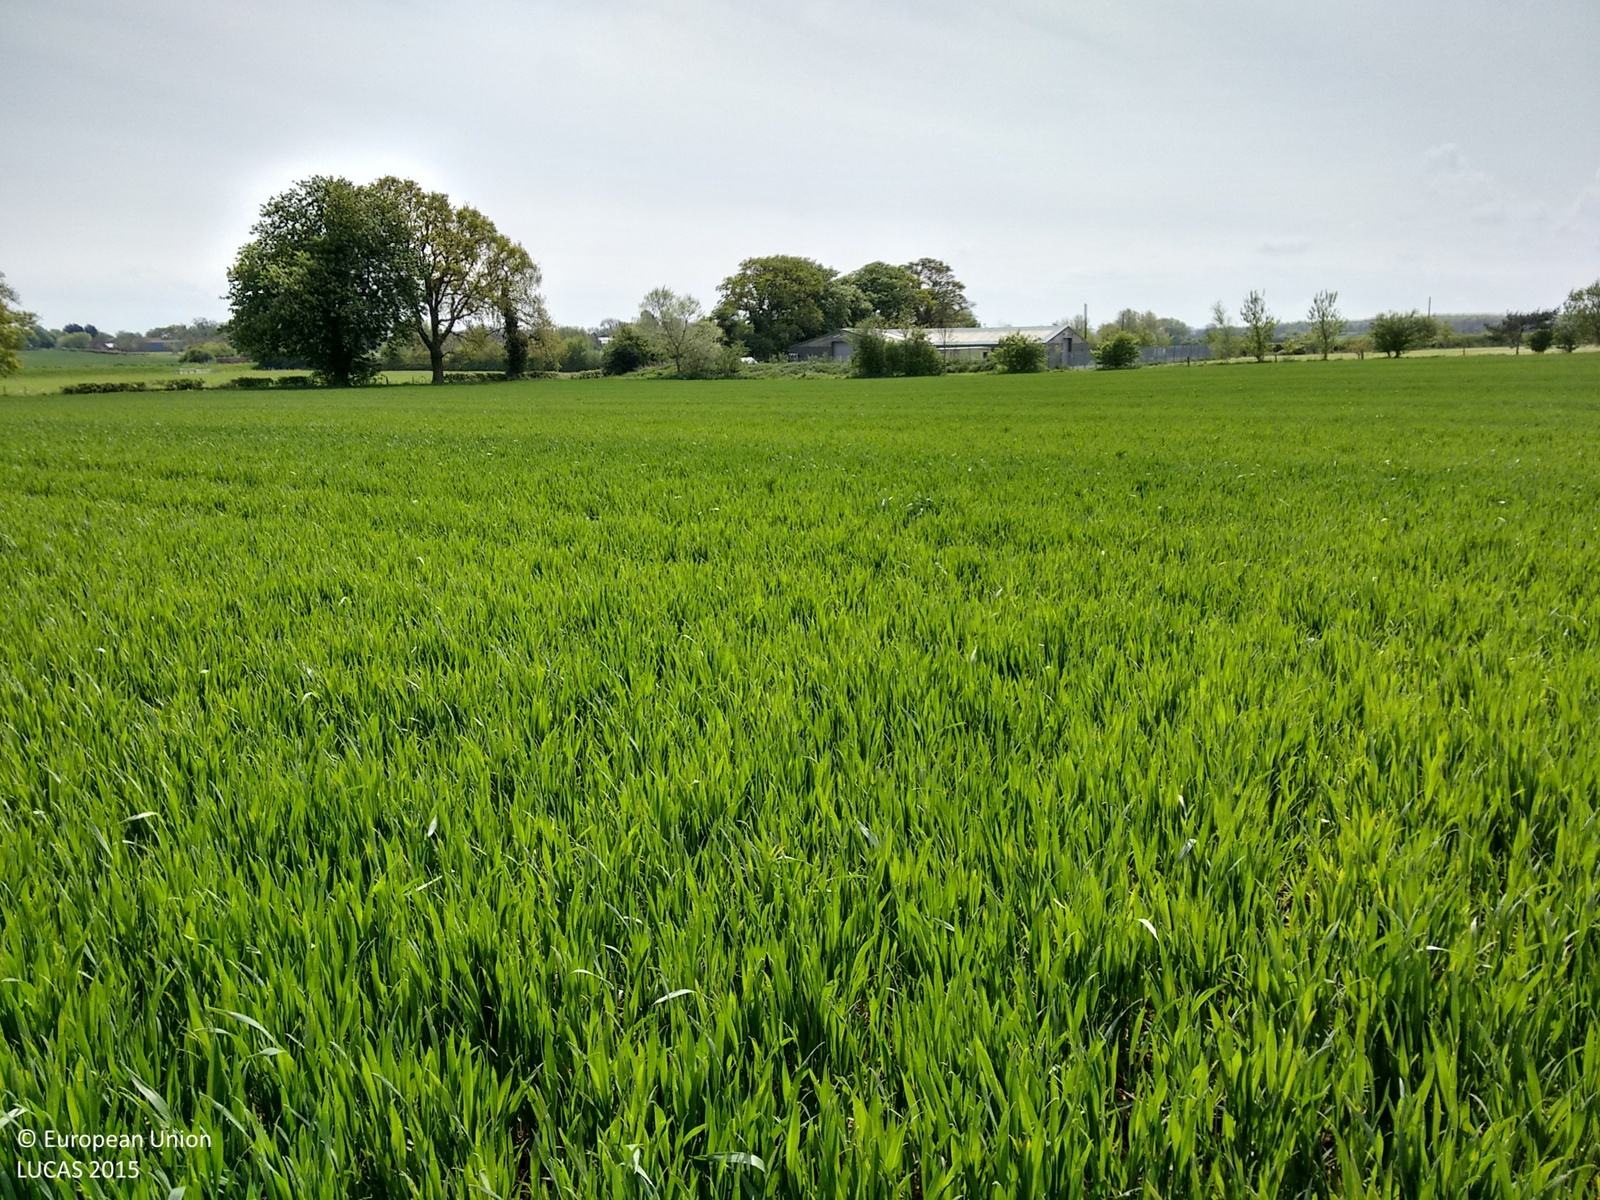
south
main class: Cropland
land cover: Common wheat
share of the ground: > 75 %
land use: Agriculture (excluding fallow land and kitchen gardens)
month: May
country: GB
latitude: 53.3244
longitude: 0.1357
